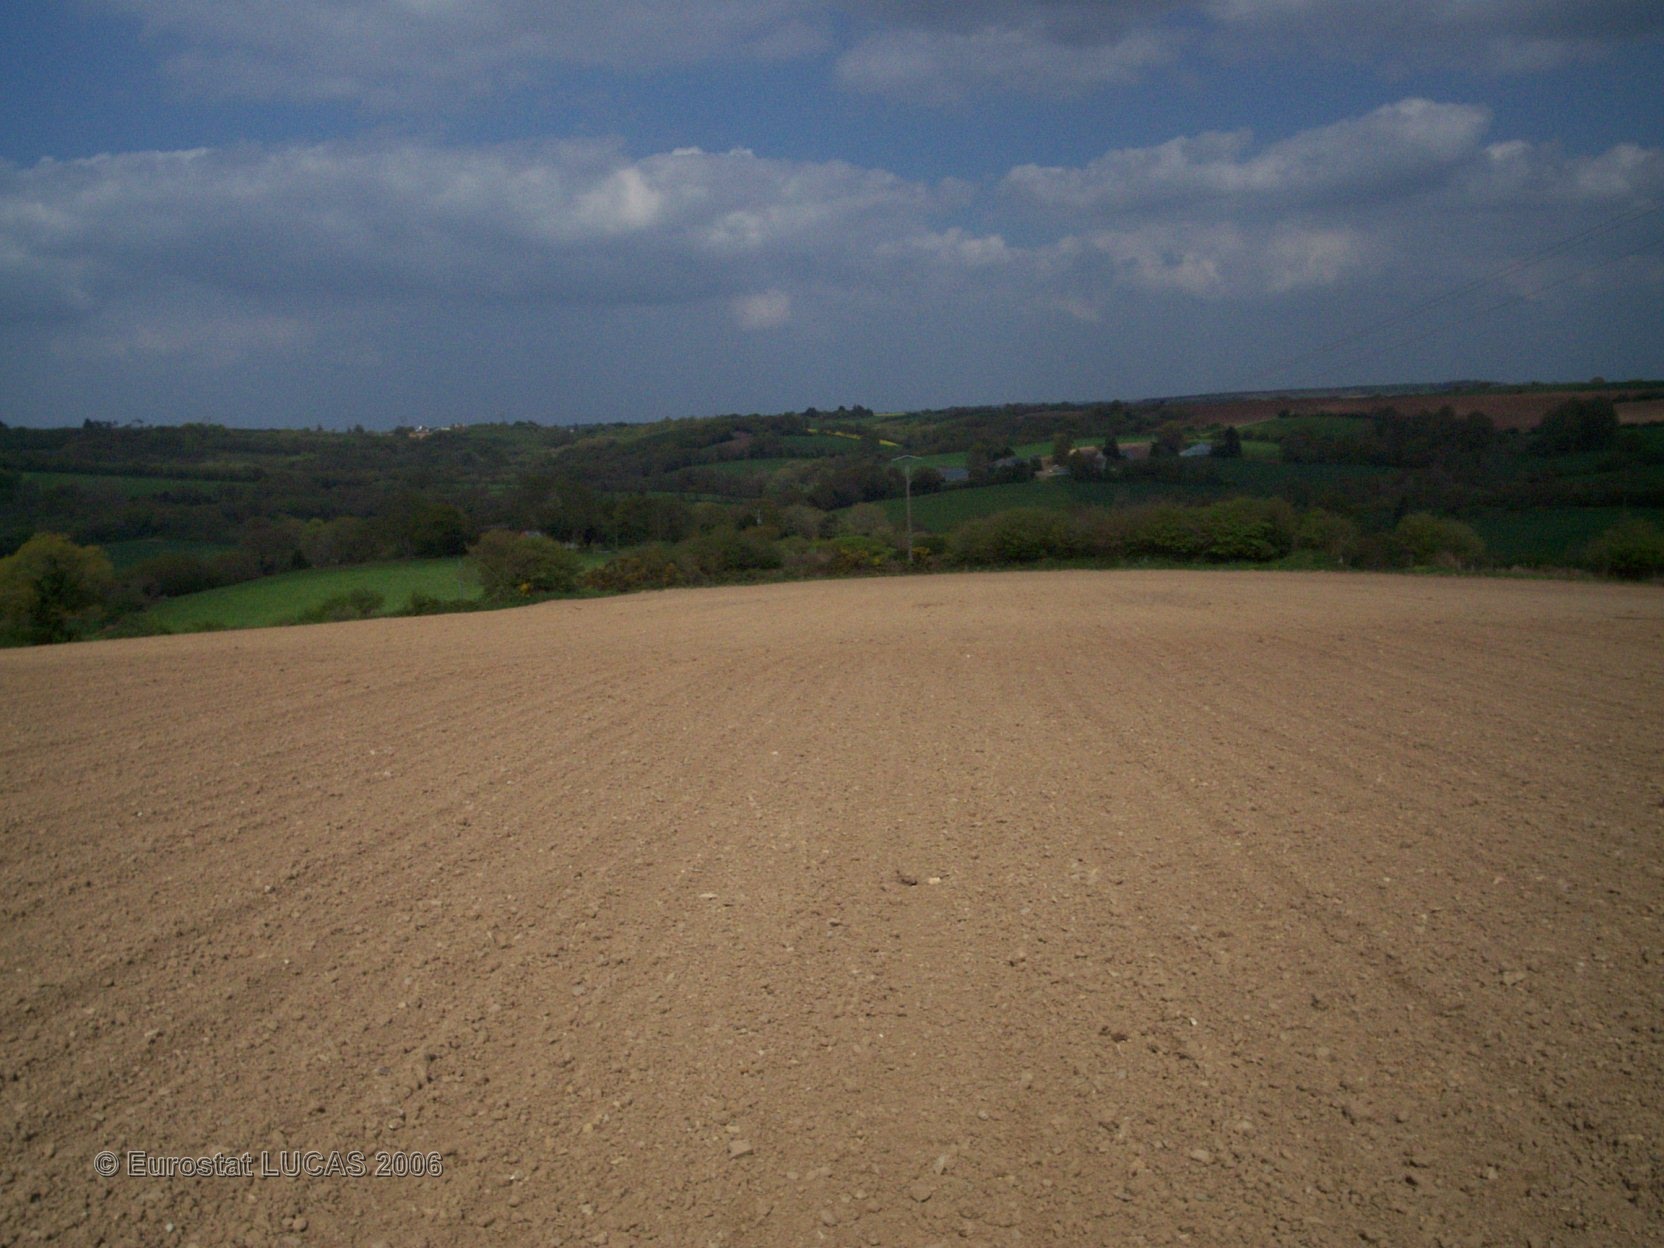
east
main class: Cropland
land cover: Maize
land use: Agriculture (excluding fallow land and kitchen gardens)
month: May
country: FR
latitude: 48.4085
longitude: -3.6585
